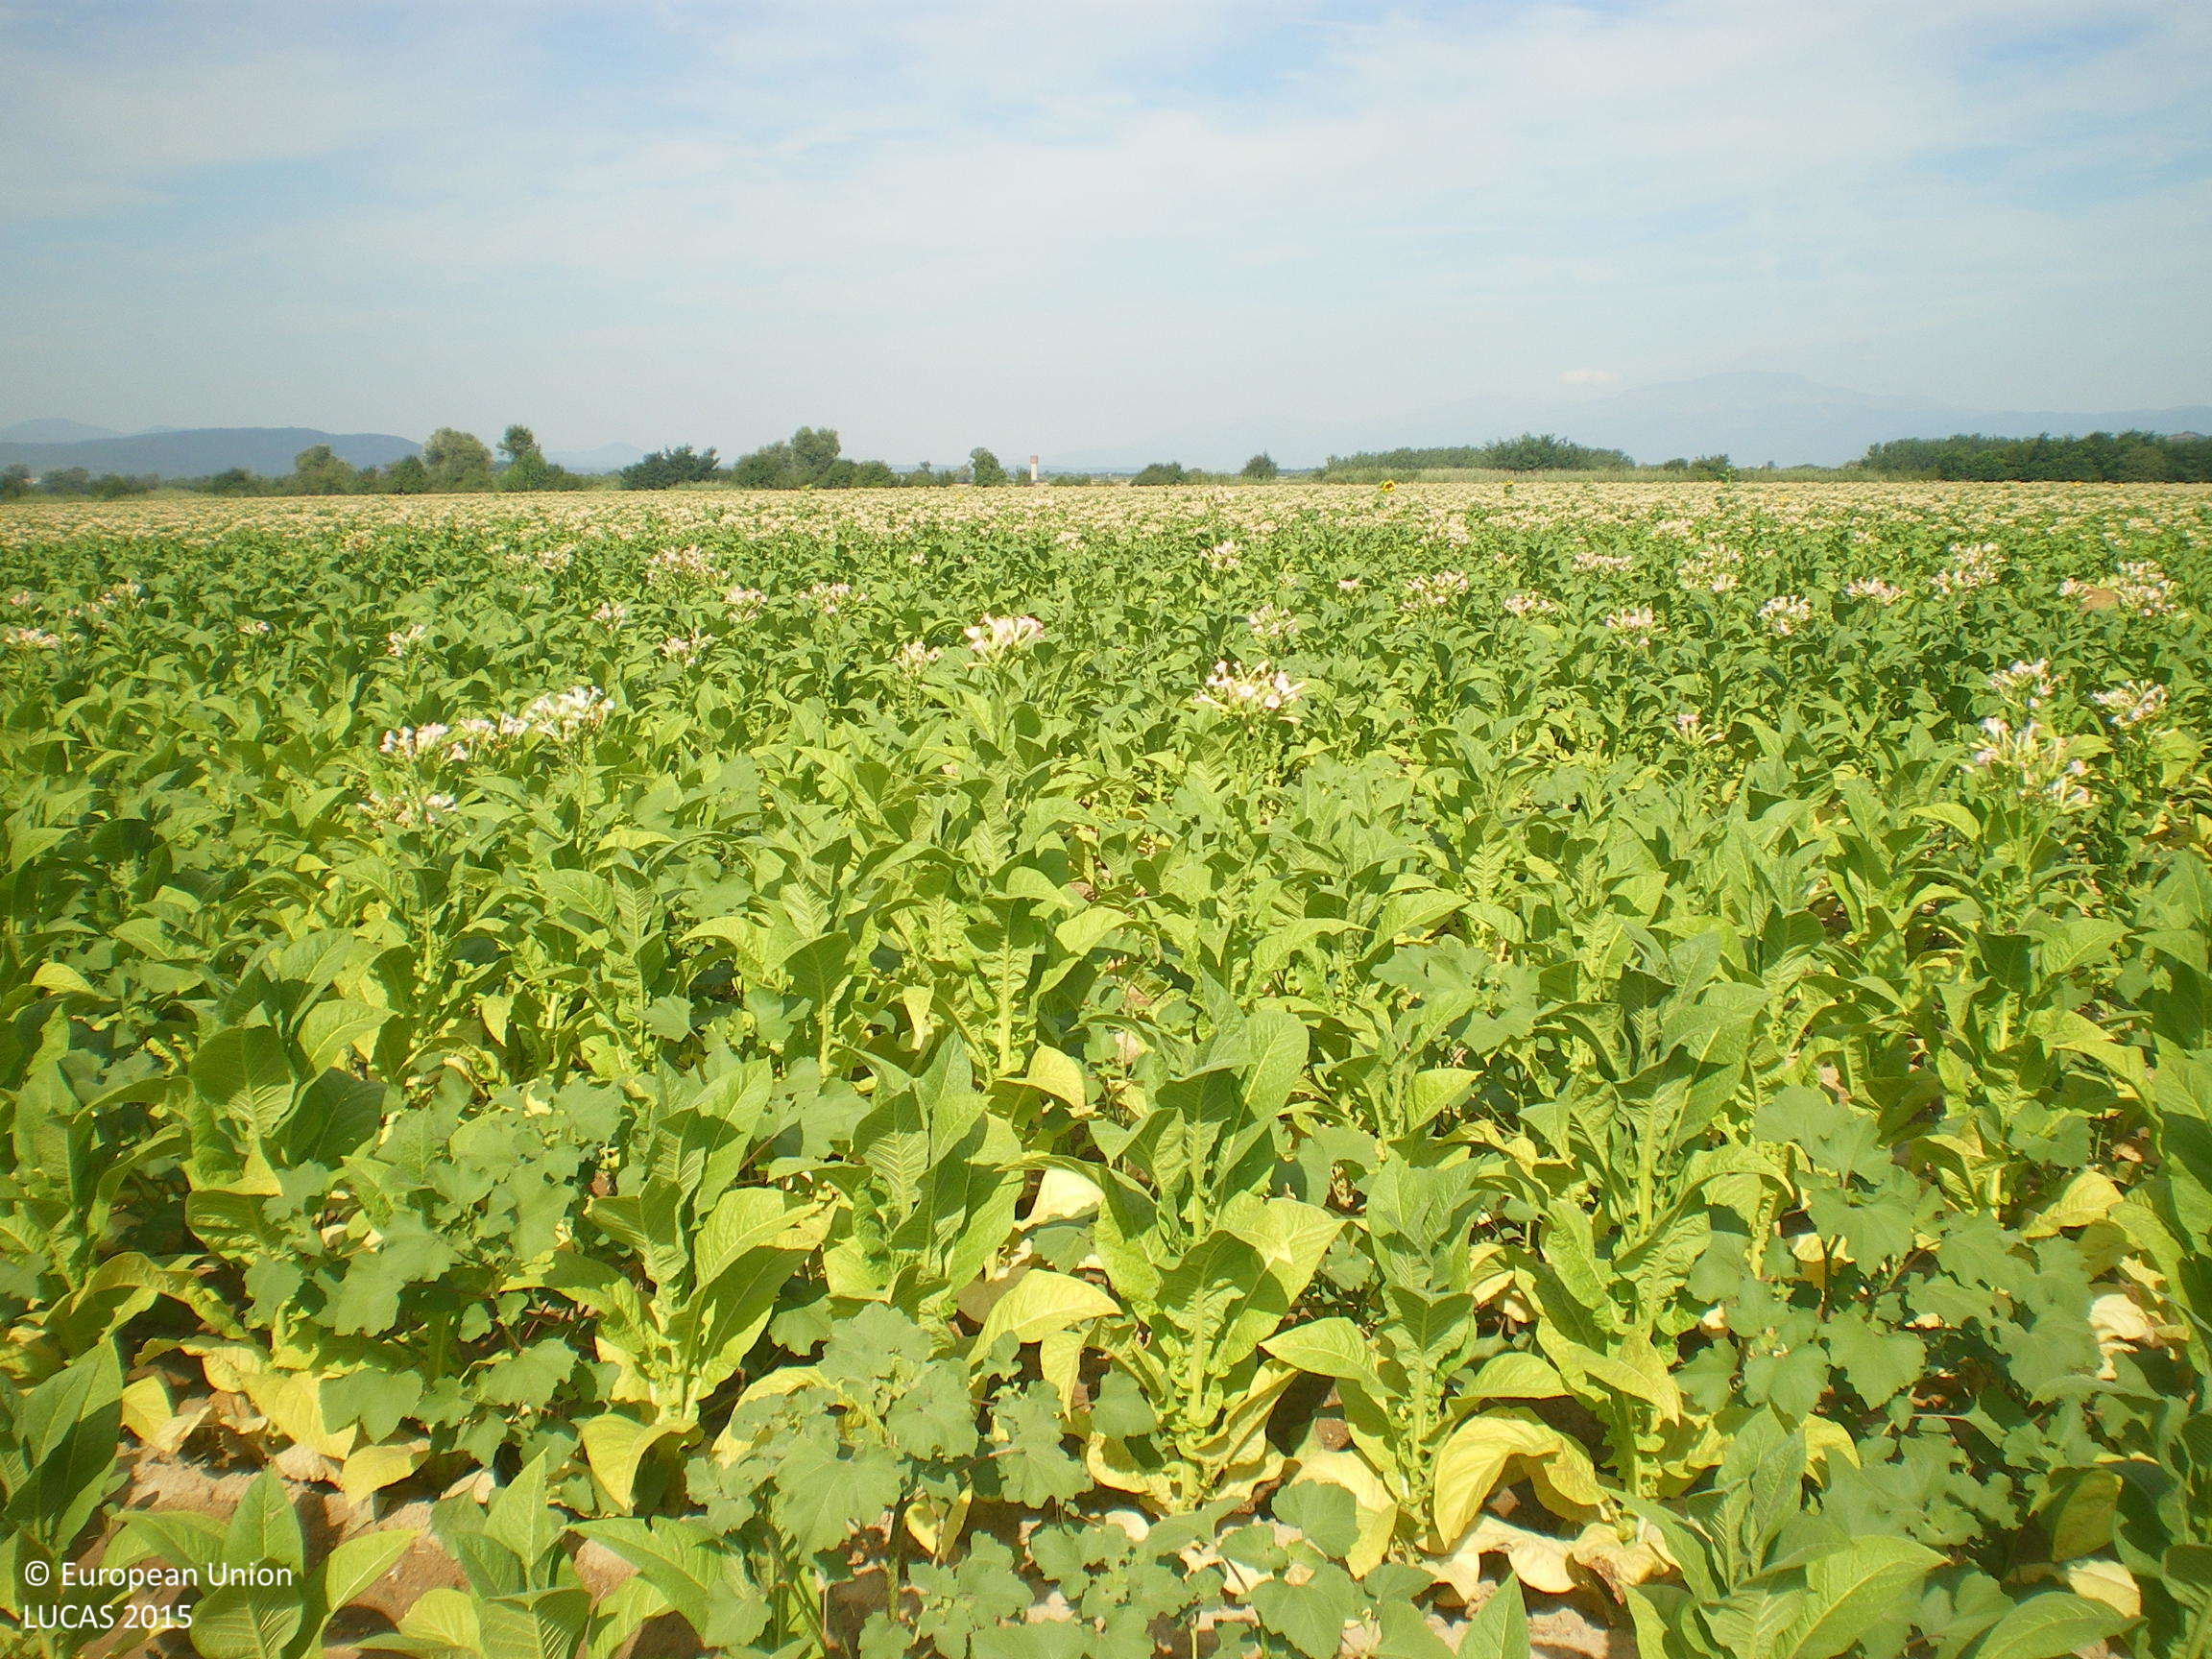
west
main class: Cropland
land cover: Tobacco
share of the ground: > 75 %
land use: Agriculture (excluding fallow land and kitchen gardens)
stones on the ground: < 10 %
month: August
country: BG
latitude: 42.5887
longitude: 25.5108
